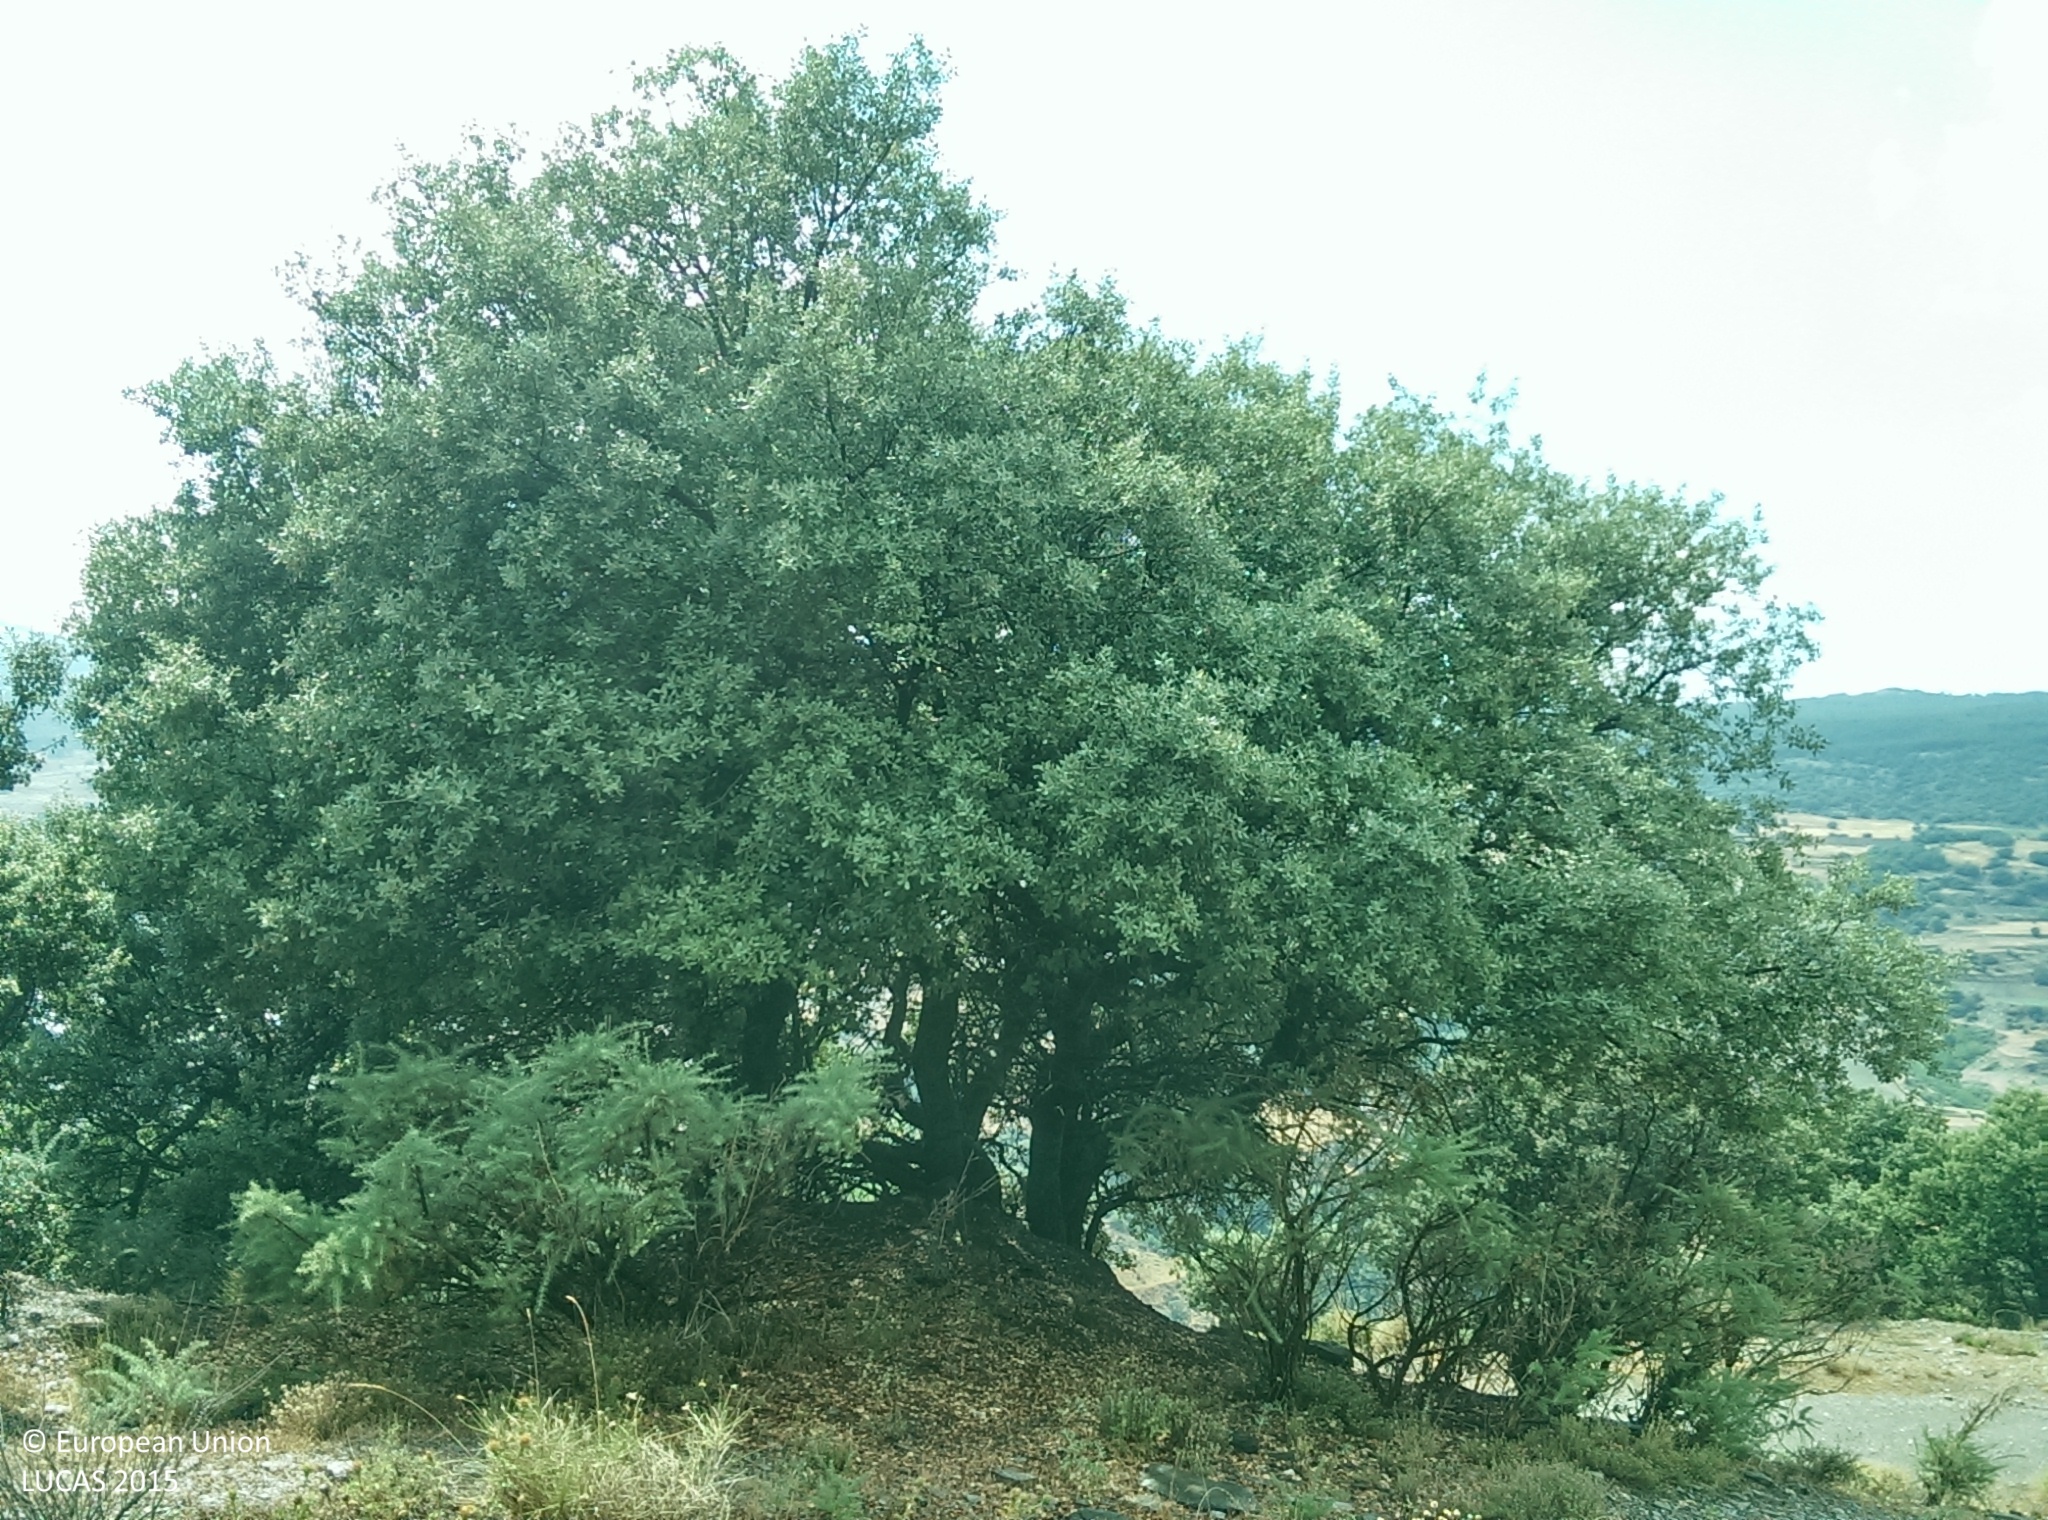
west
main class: Woodland
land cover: Broadleaved woodland
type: broadleaved evergreen forest
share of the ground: 50 - 75 %
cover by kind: broadleaved forest trees 65 %, shrubs 15 %, herbaceous plants 15 %, unconsolidated bare surface 5 %
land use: Forestry
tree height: > 5 m
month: July
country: ES
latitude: 37.0145
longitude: -3.1437
